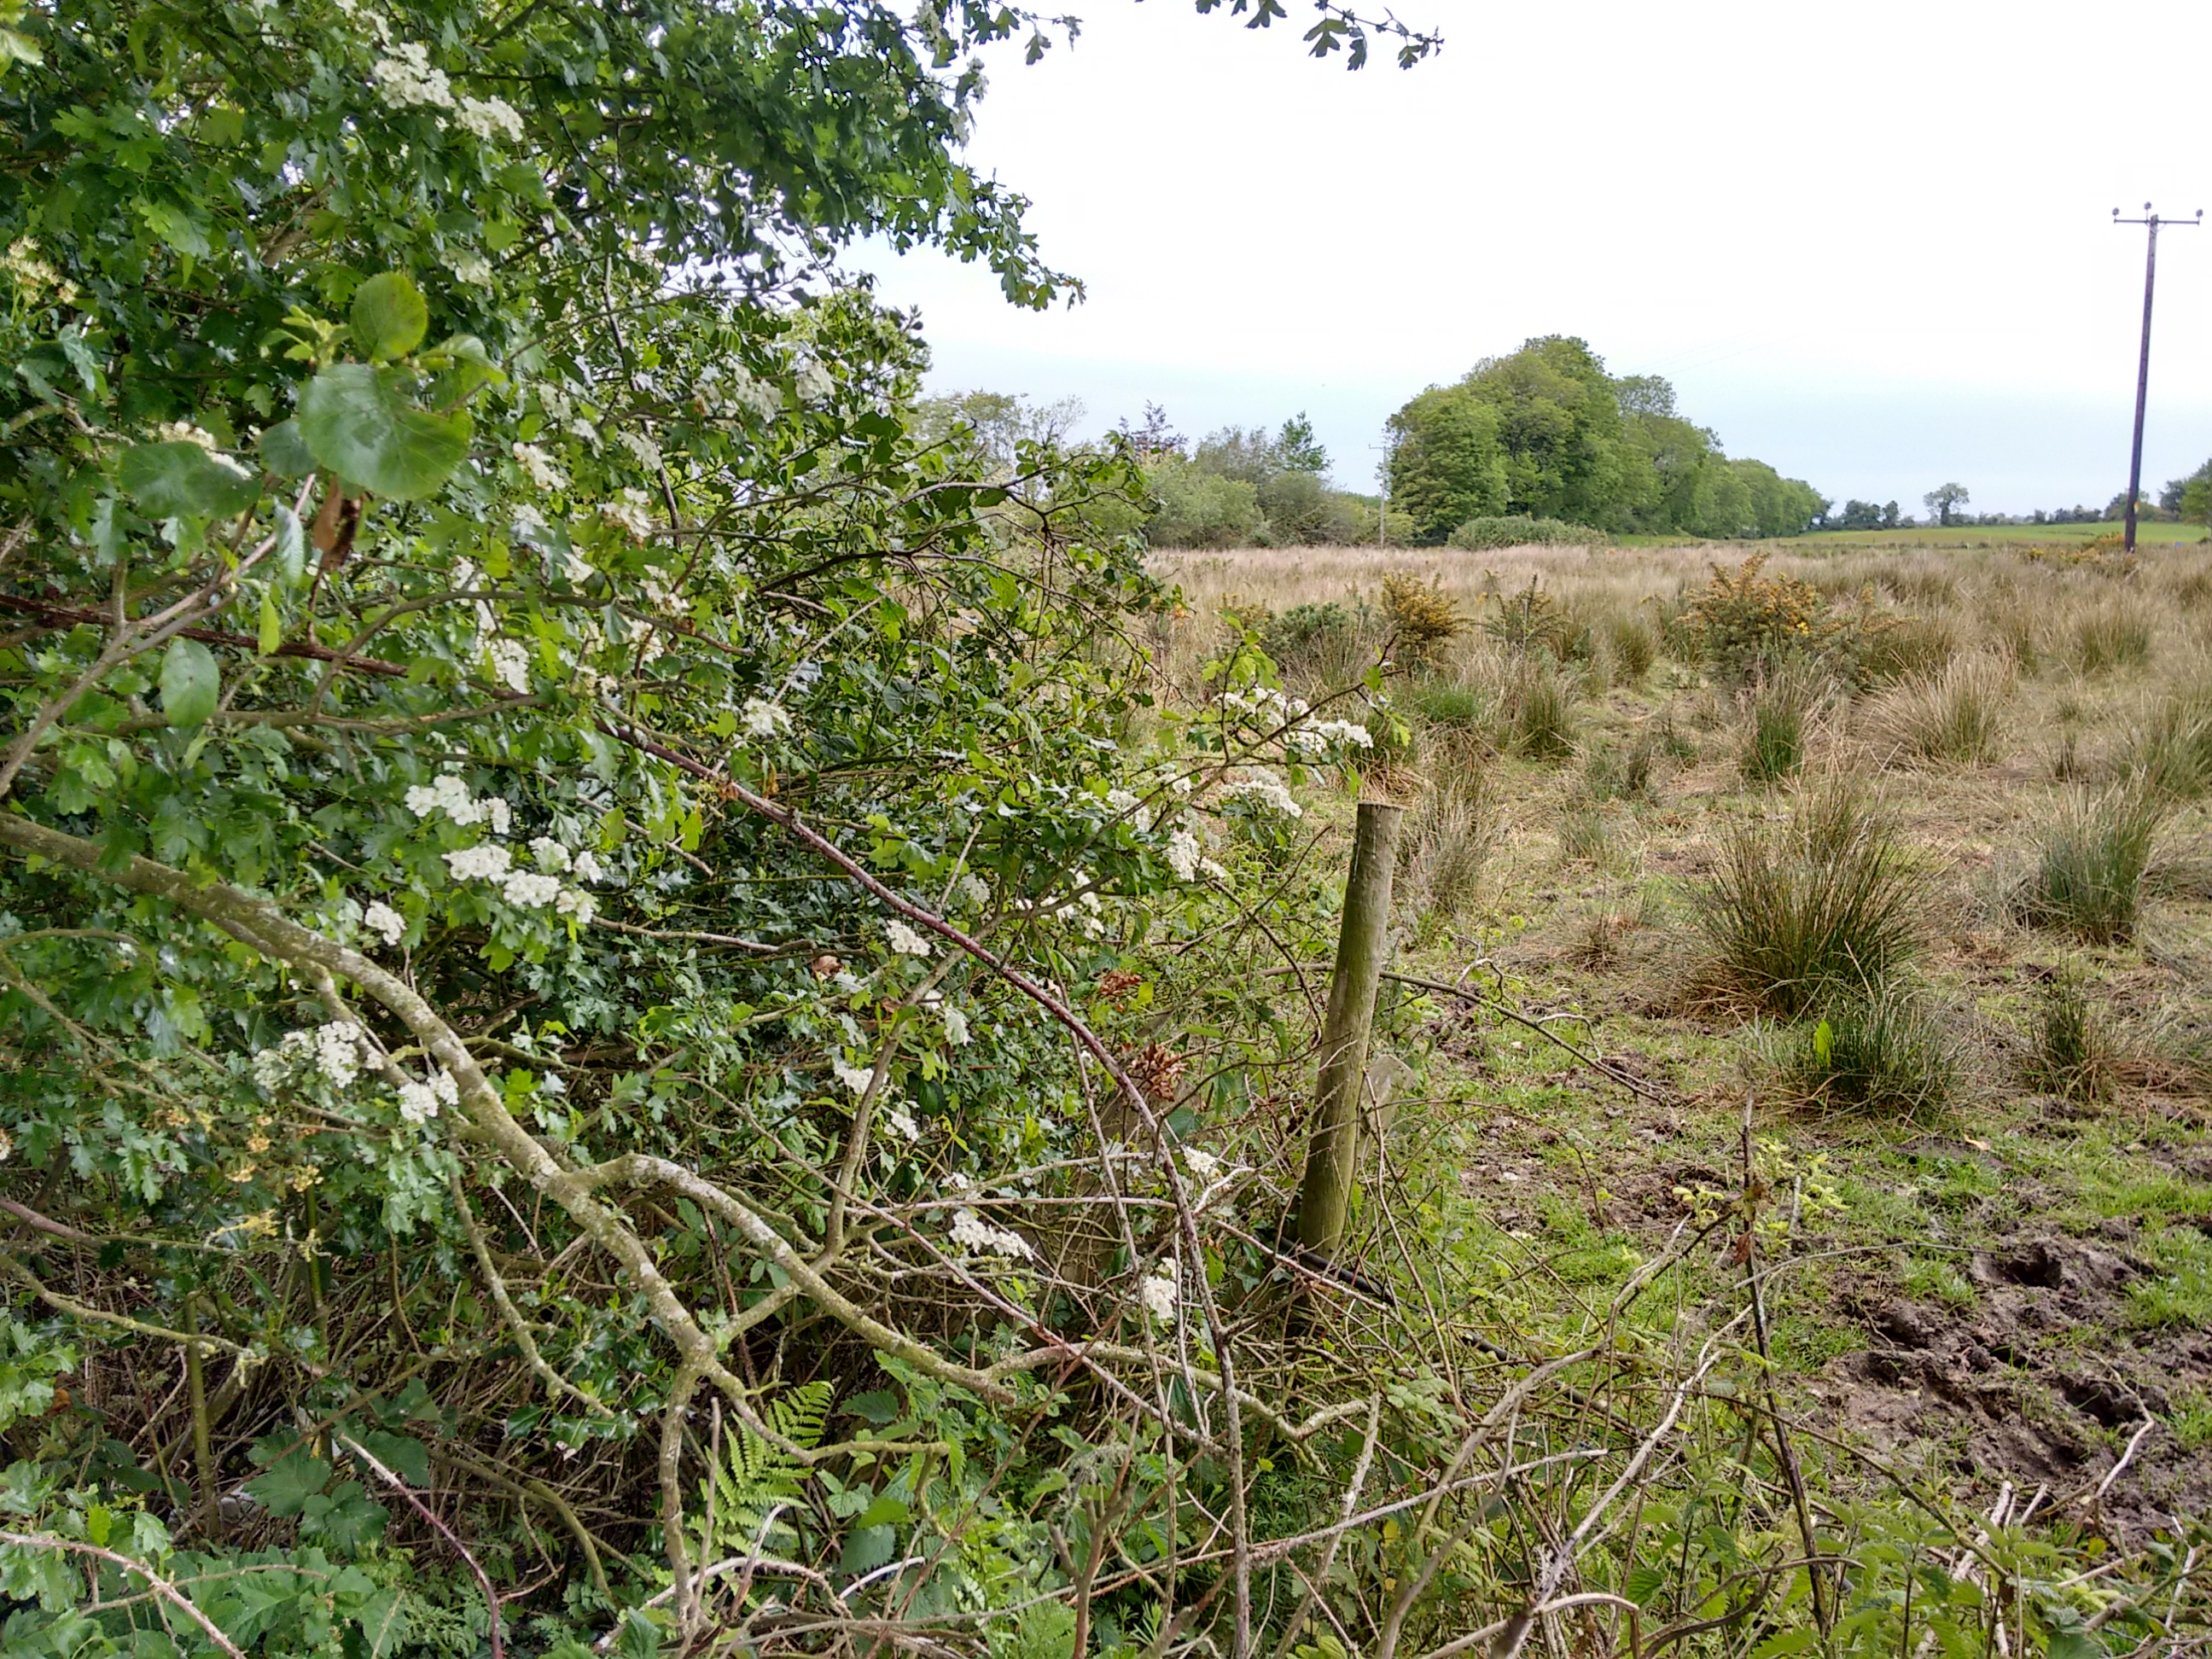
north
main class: Grassland
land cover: Grassland without tree/shrub cover
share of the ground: > 75 %
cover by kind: herbaceous plants 100 %
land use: Agriculture (excluding fallow land and kitchen gardens)
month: June
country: IE
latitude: 53.4333
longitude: -8.6369
